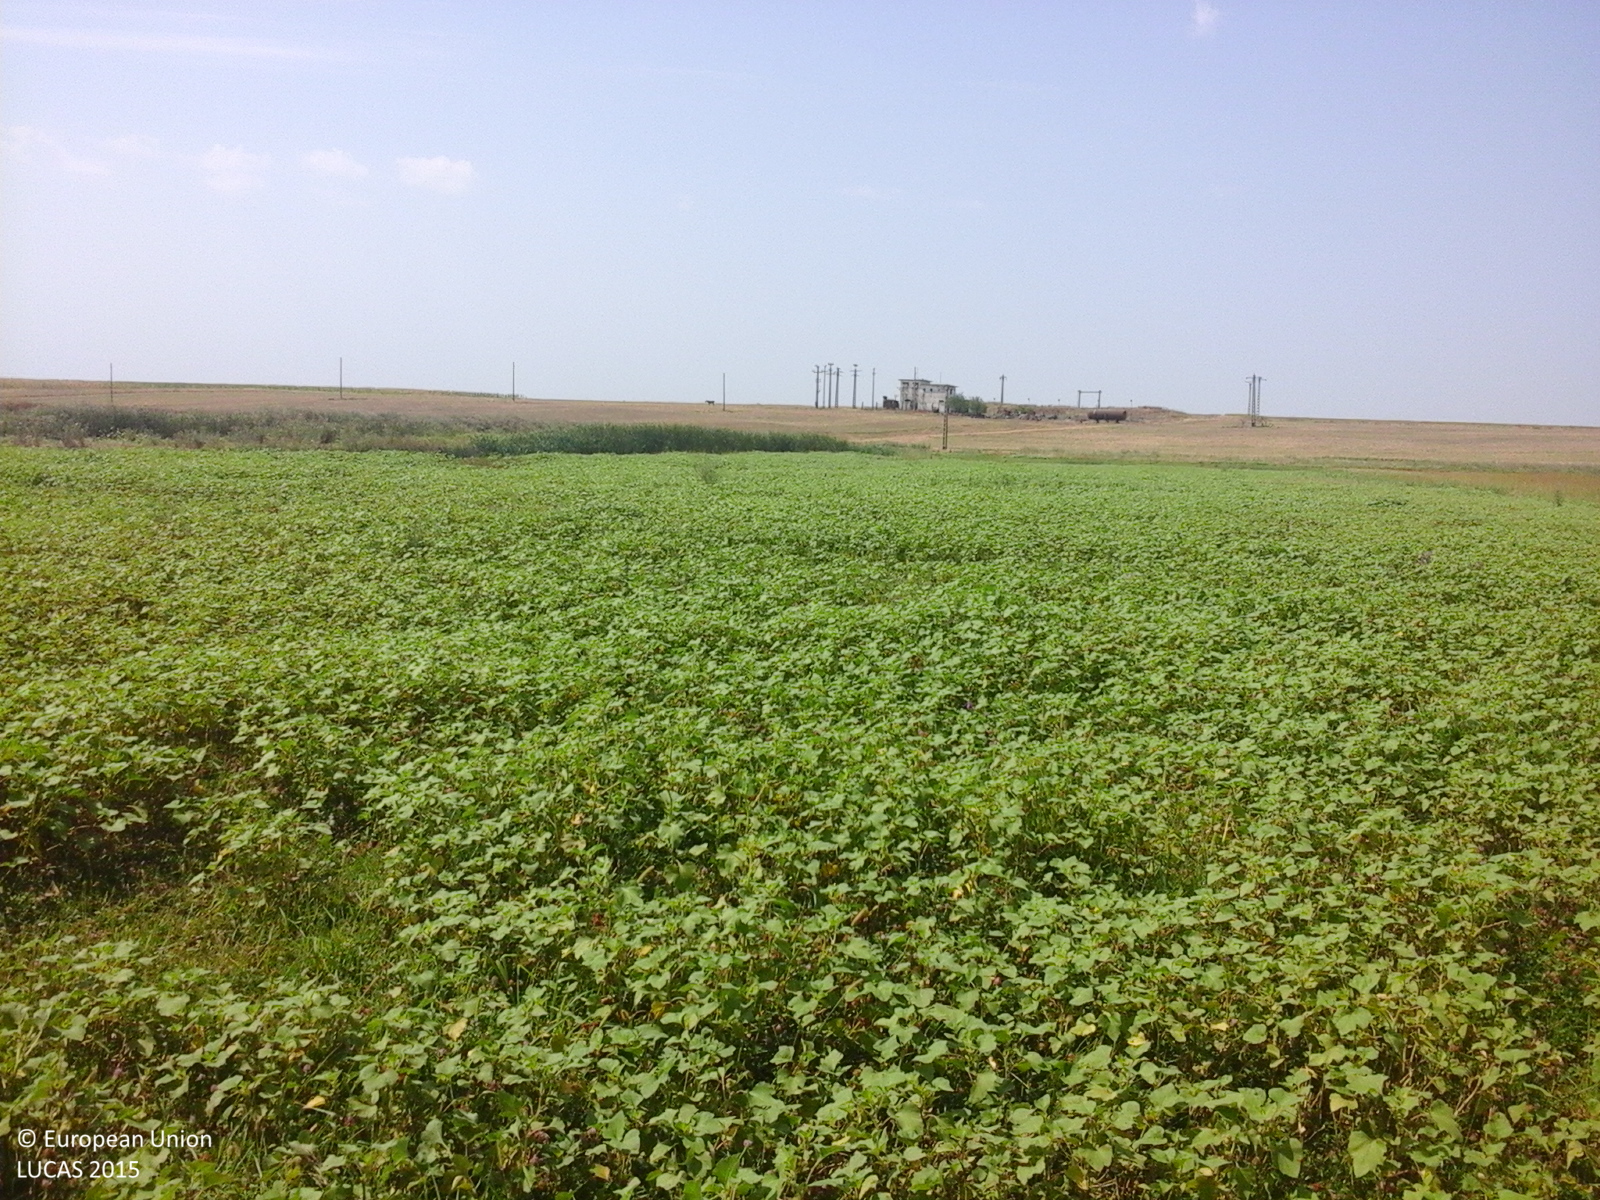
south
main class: Grassland
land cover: Spontaneously vegetated surfaces
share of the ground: > 75 %
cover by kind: herbaceous plants 100 %
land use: Agriculture (excluding fallow land and kitchen gardens)
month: August
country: RO
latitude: 44.1732
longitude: 23.2417
